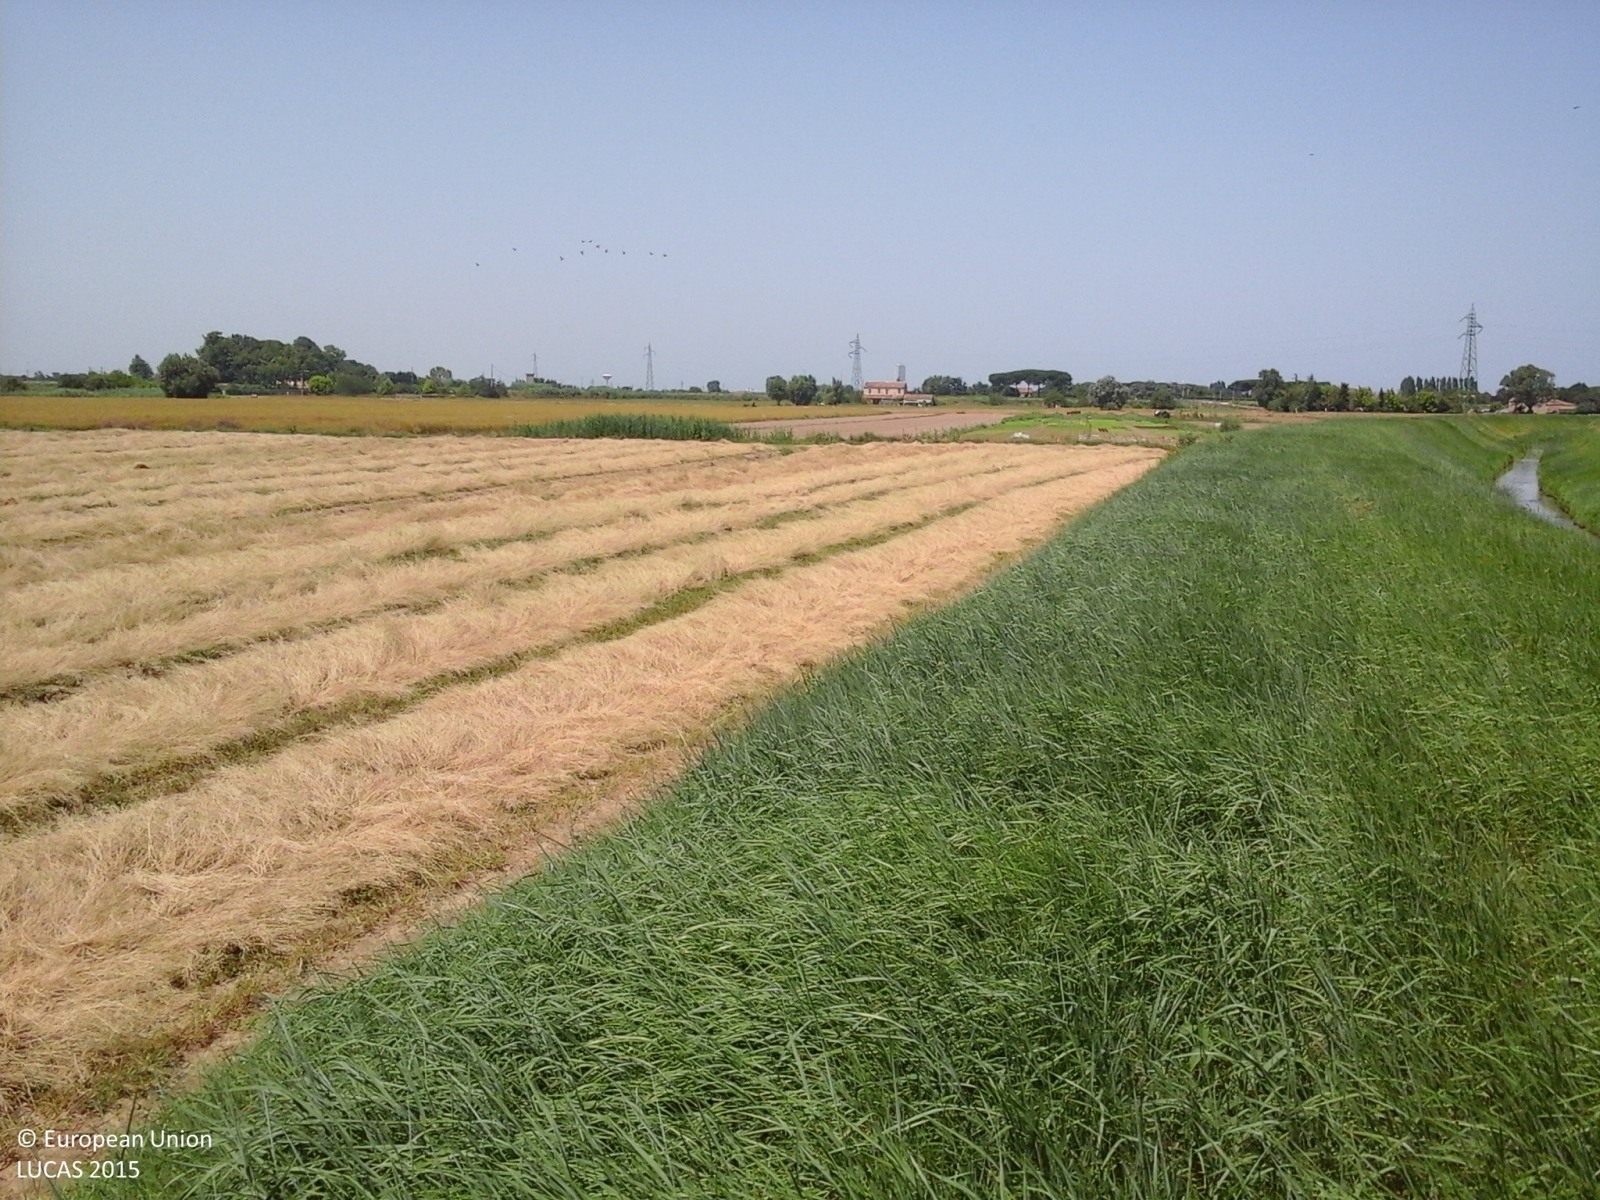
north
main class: Grassland
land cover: Grassland without tree/shrub cover
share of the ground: > 75 %
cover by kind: herbaceous plants 100 %
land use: Semi-natural and natural areas not in use
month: July
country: IT
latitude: 44.1602
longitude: 12.4080
